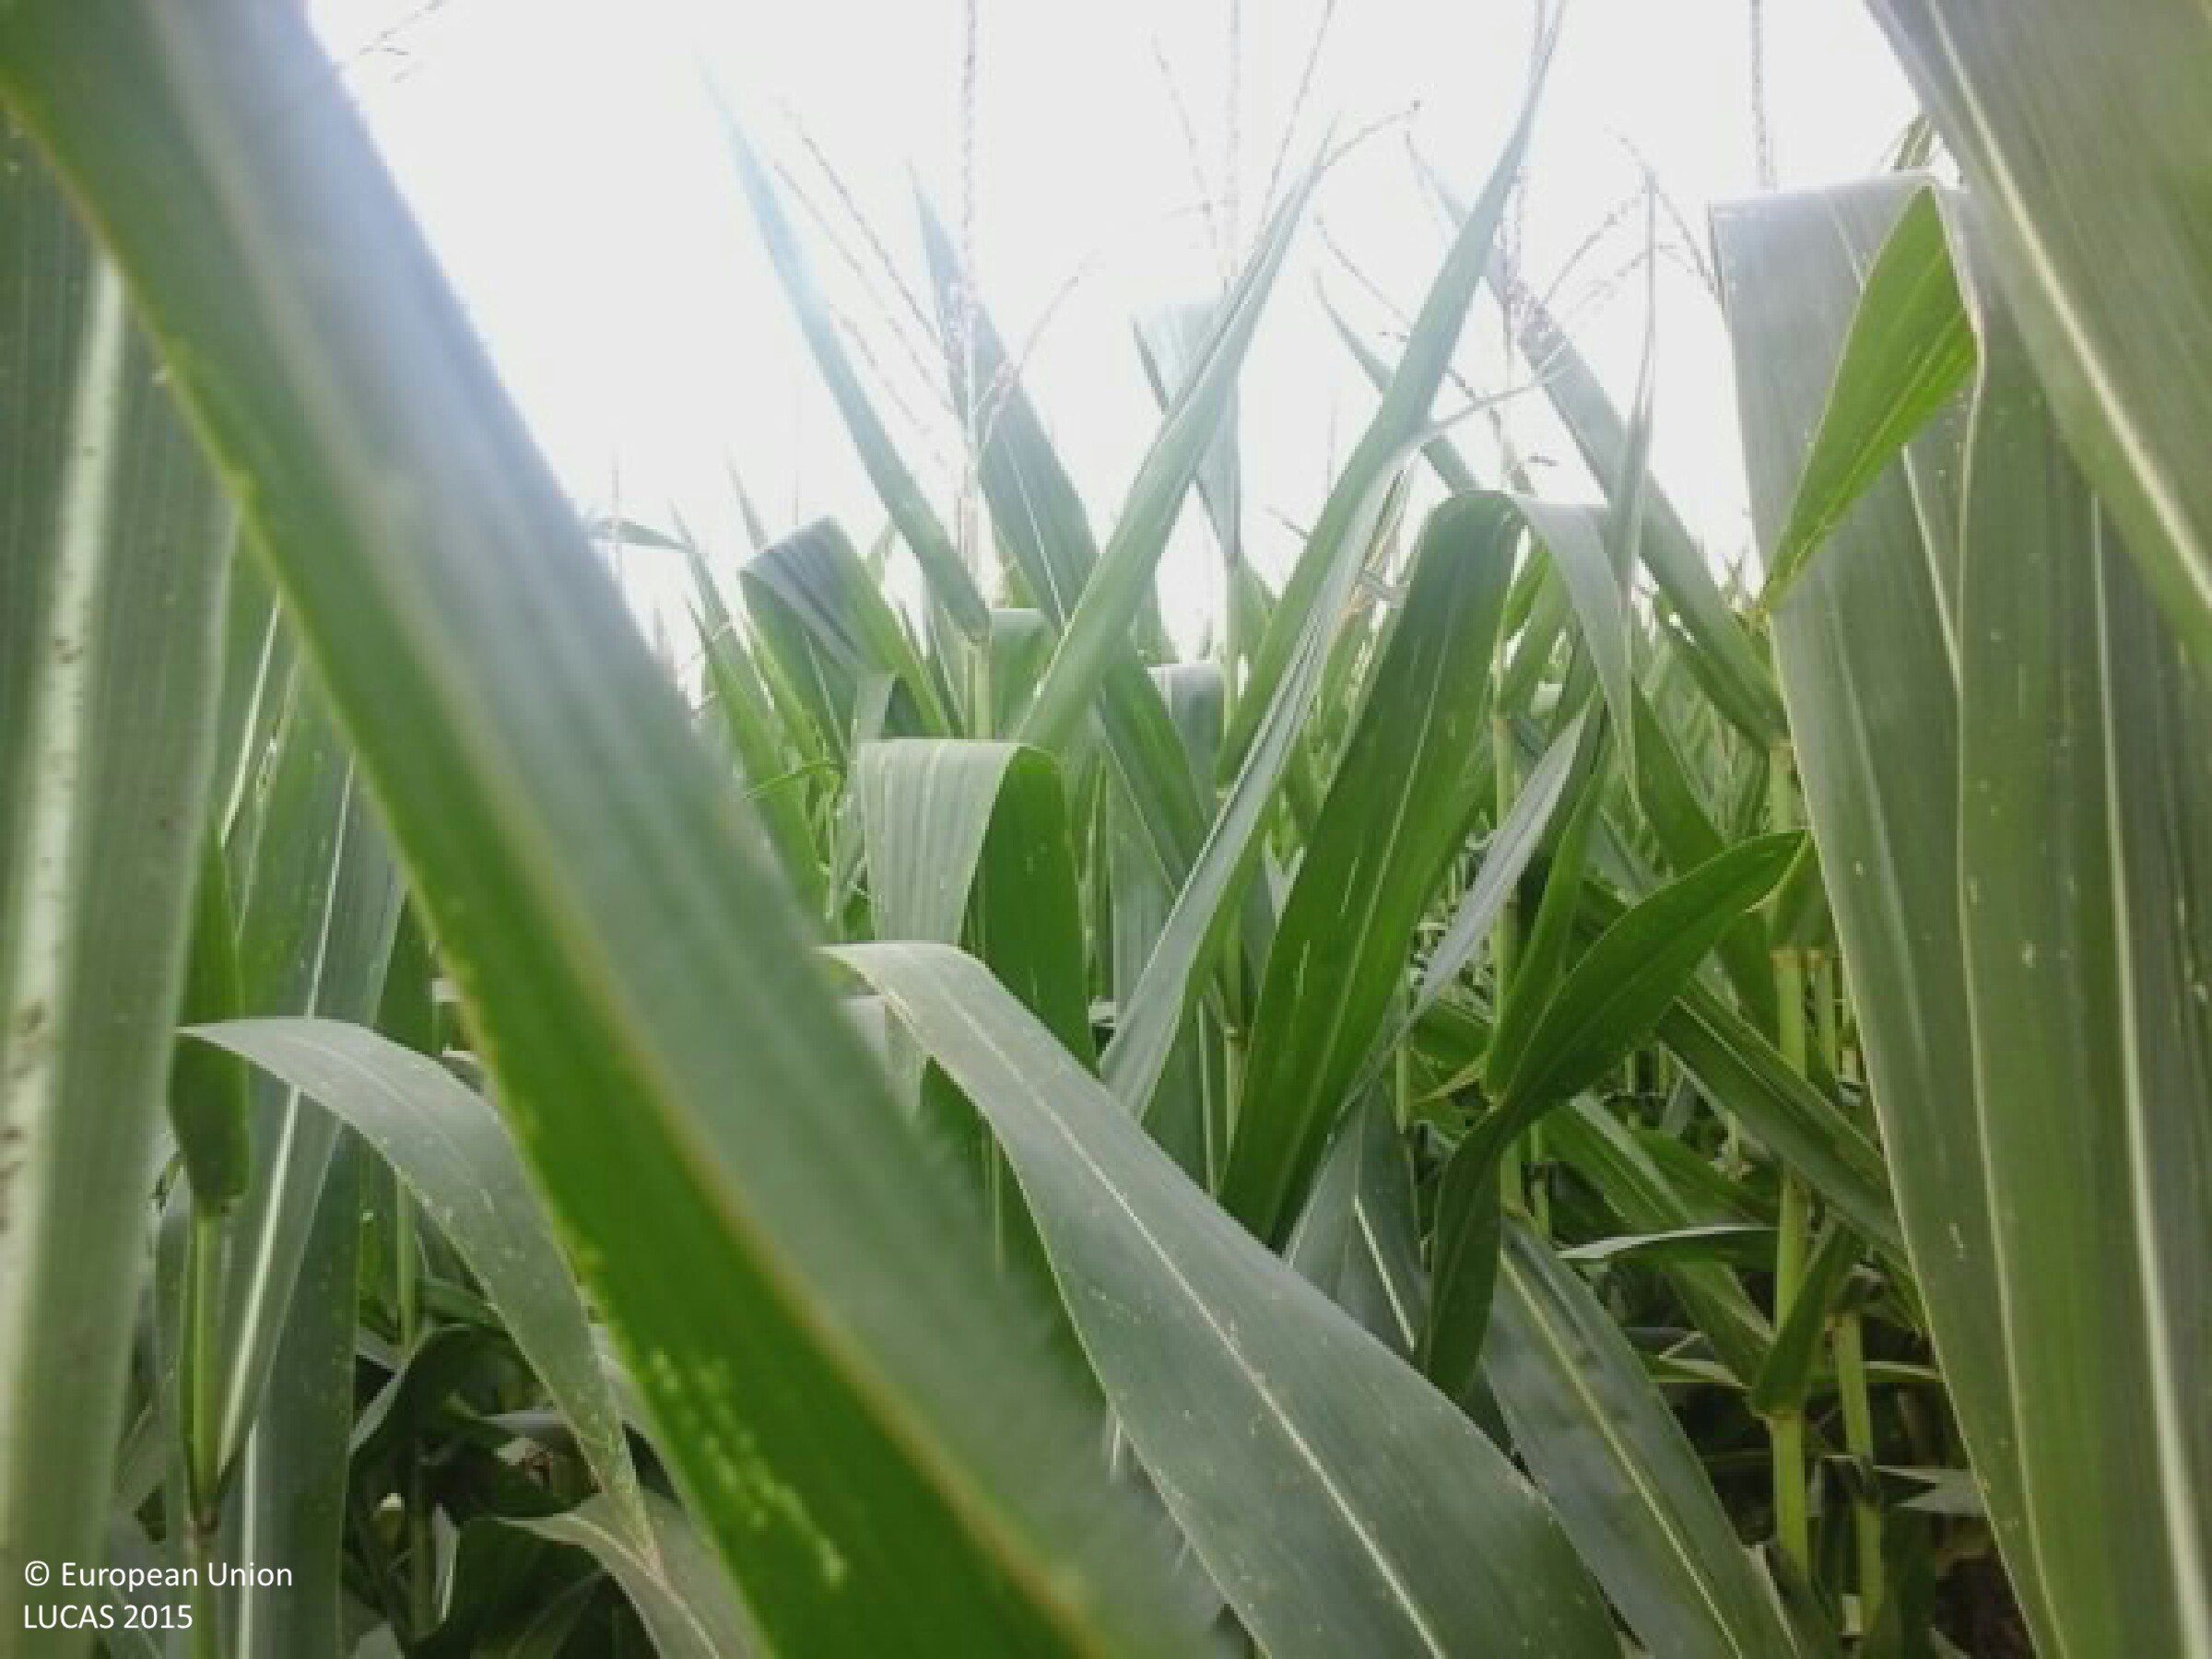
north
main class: Cropland
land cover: Maize
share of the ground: > 75 %
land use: Agriculture (excluding fallow land and kitchen gardens)
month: August
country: HU
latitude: 47.1758
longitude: 19.1080
